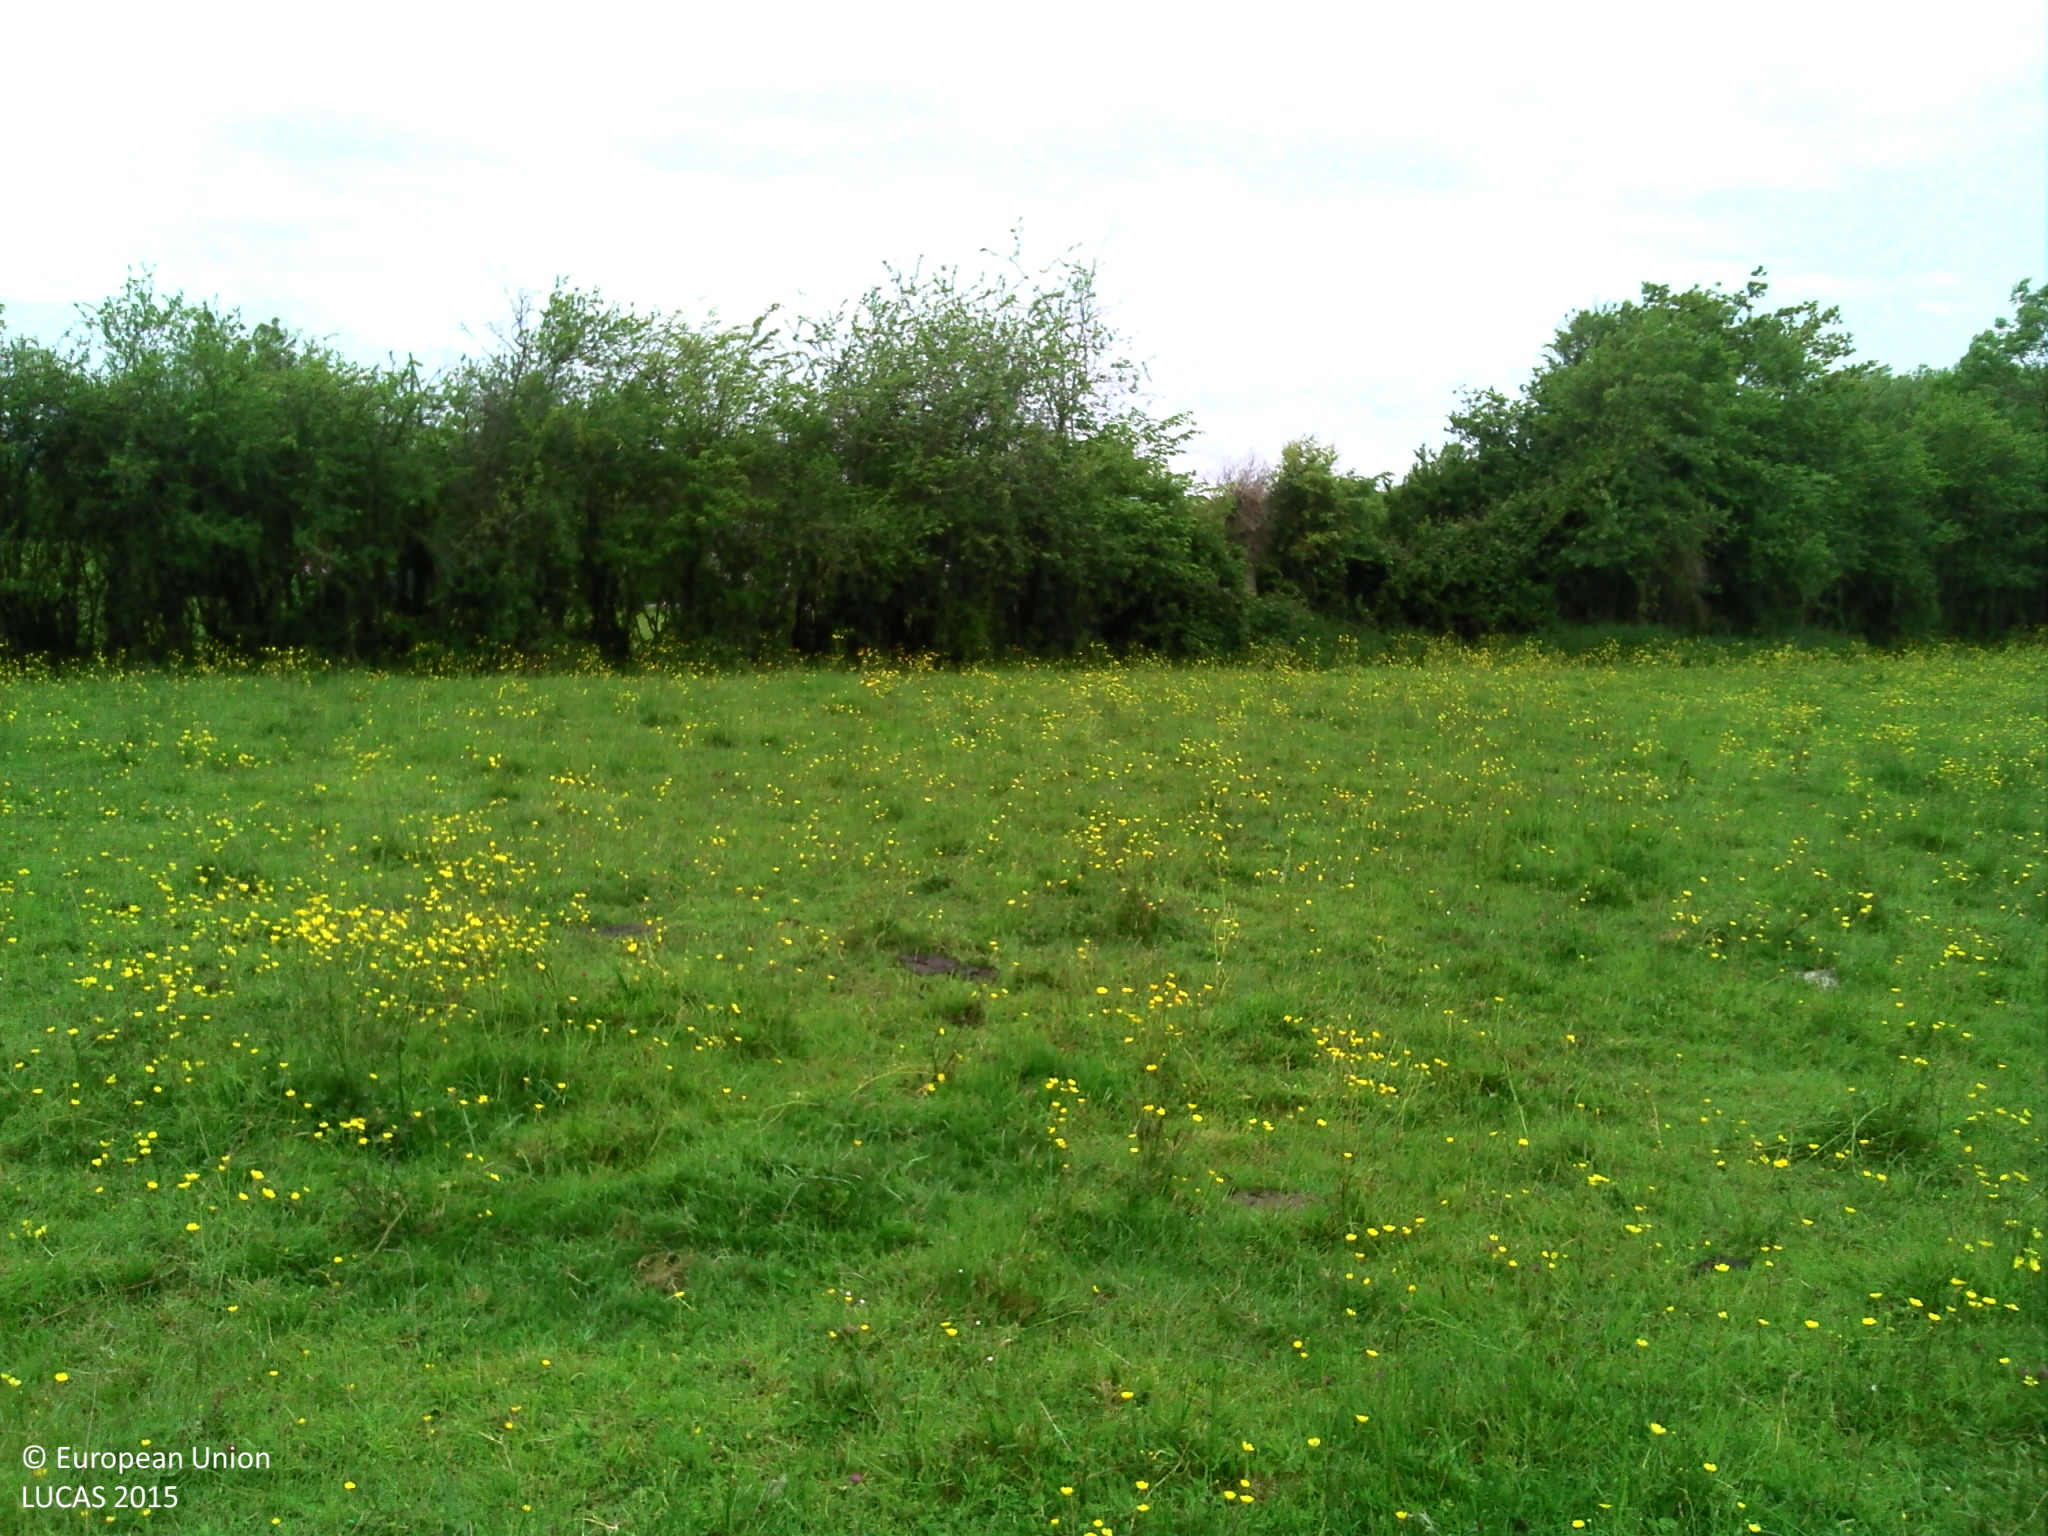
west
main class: Grassland
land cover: Grassland without tree/shrub cover
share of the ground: > 75 %
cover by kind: herbaceous plants 100 %
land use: Agriculture (excluding fallow land and kitchen gardens)
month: May
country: FR
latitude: 49.3156
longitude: 0.0788
